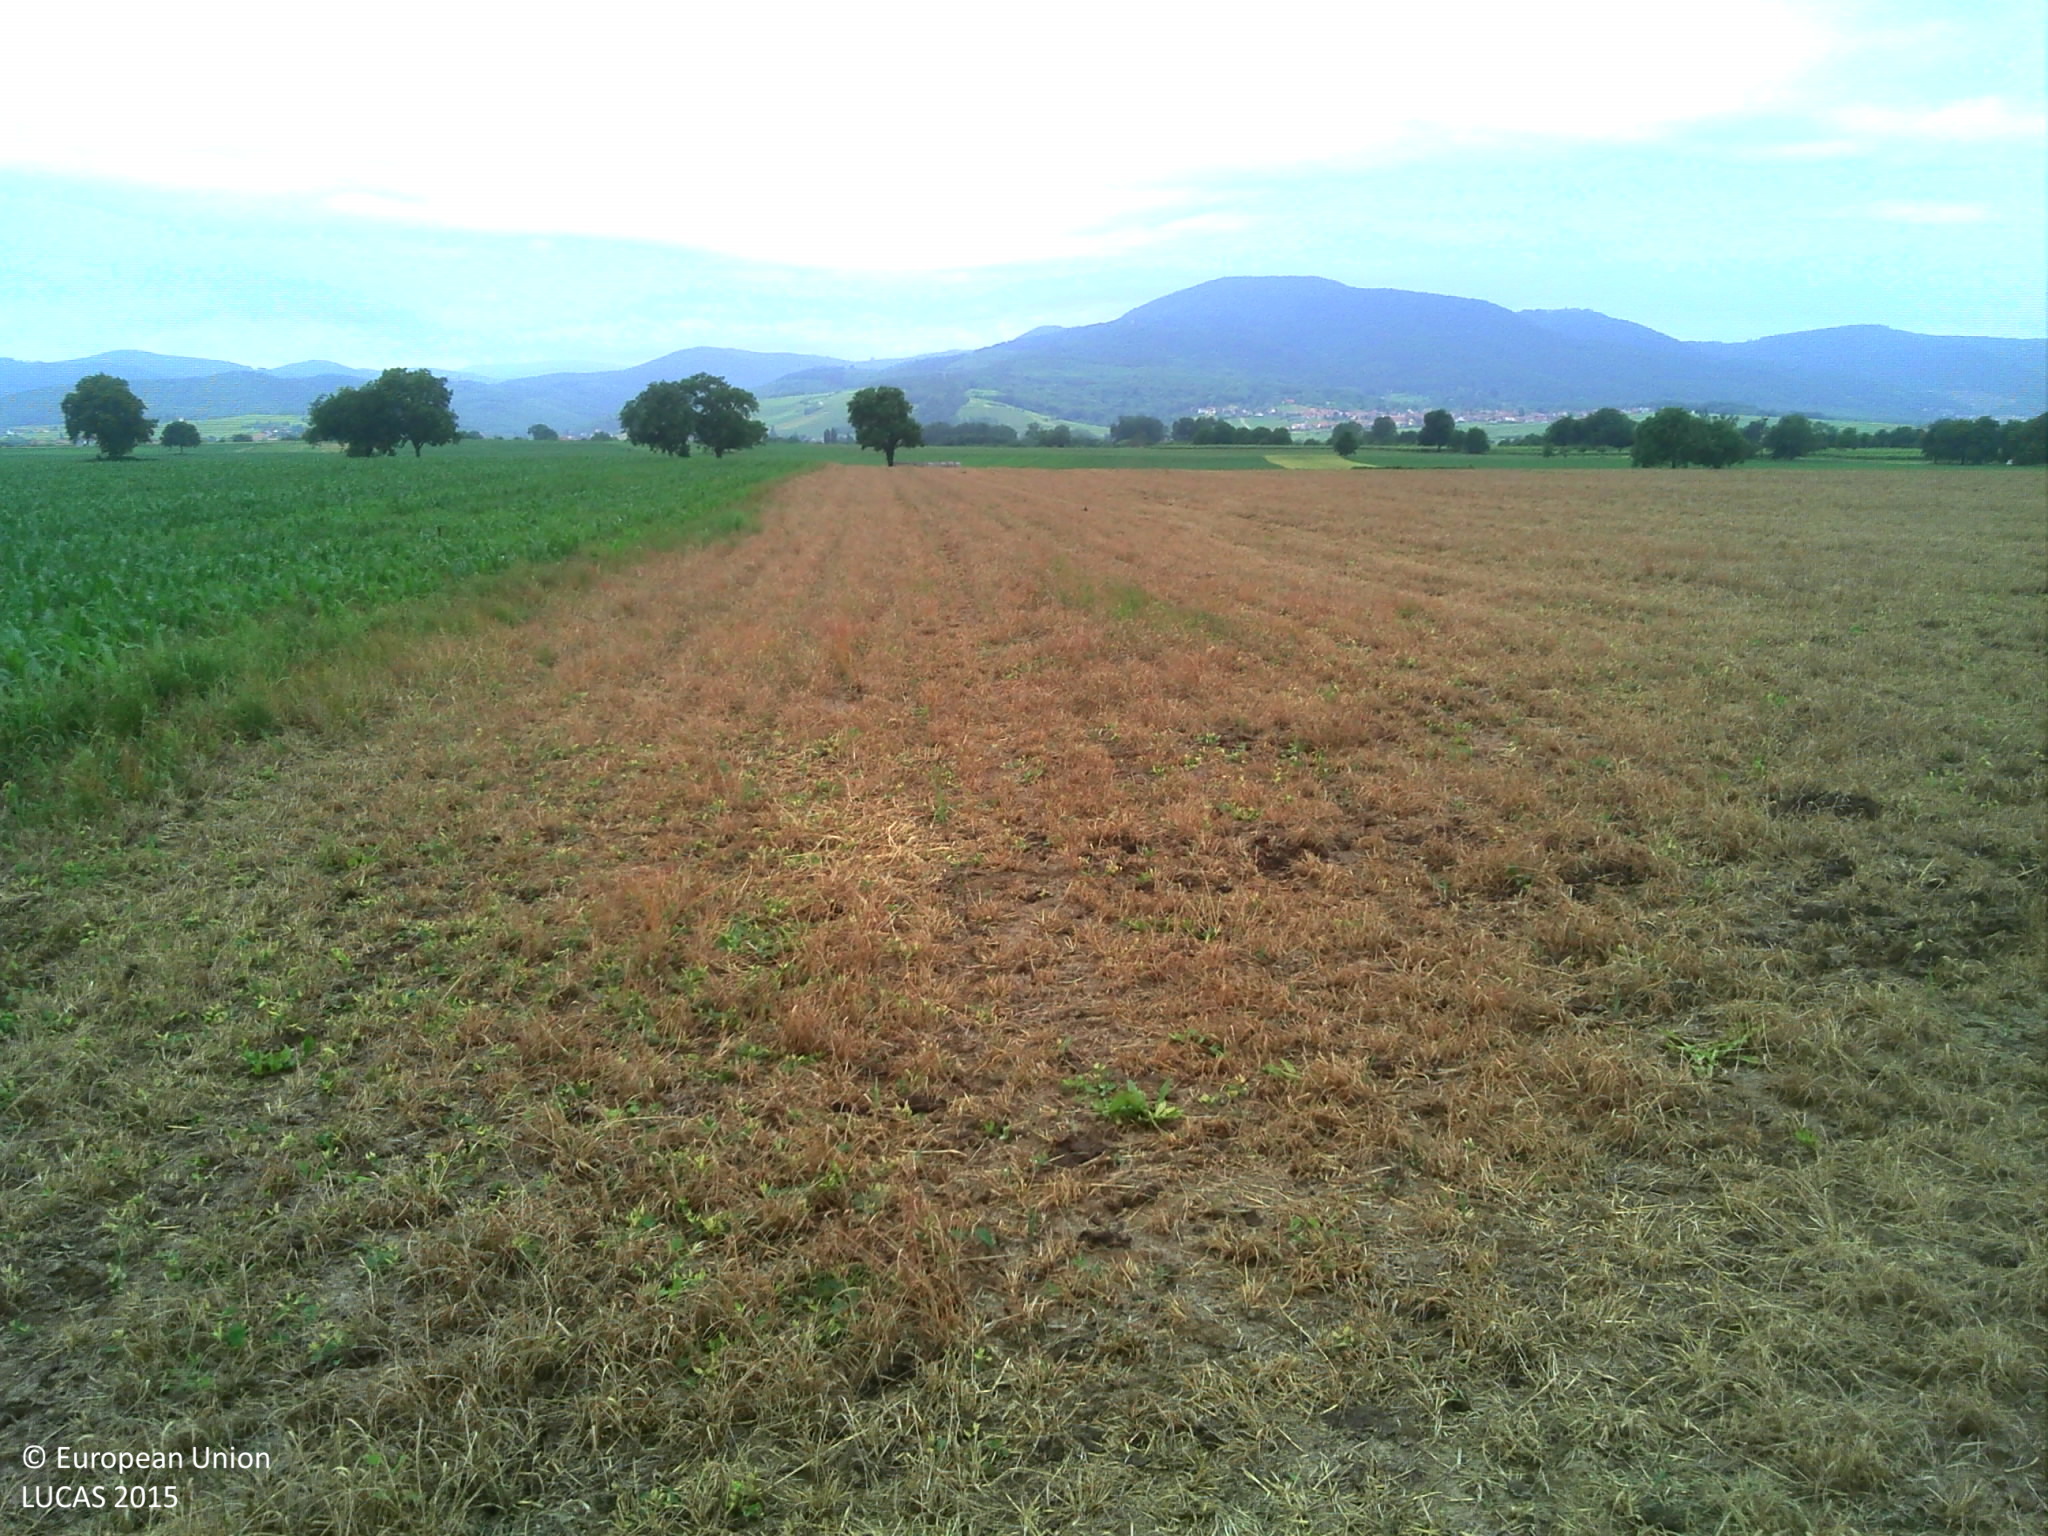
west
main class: Grassland
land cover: Grassland without tree/shrub cover
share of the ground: > 75 %
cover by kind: herbaceous plants 100 %
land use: Agriculture (excluding fallow land and kitchen gardens)
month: June
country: FR
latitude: 48.4113
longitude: 7.5015
